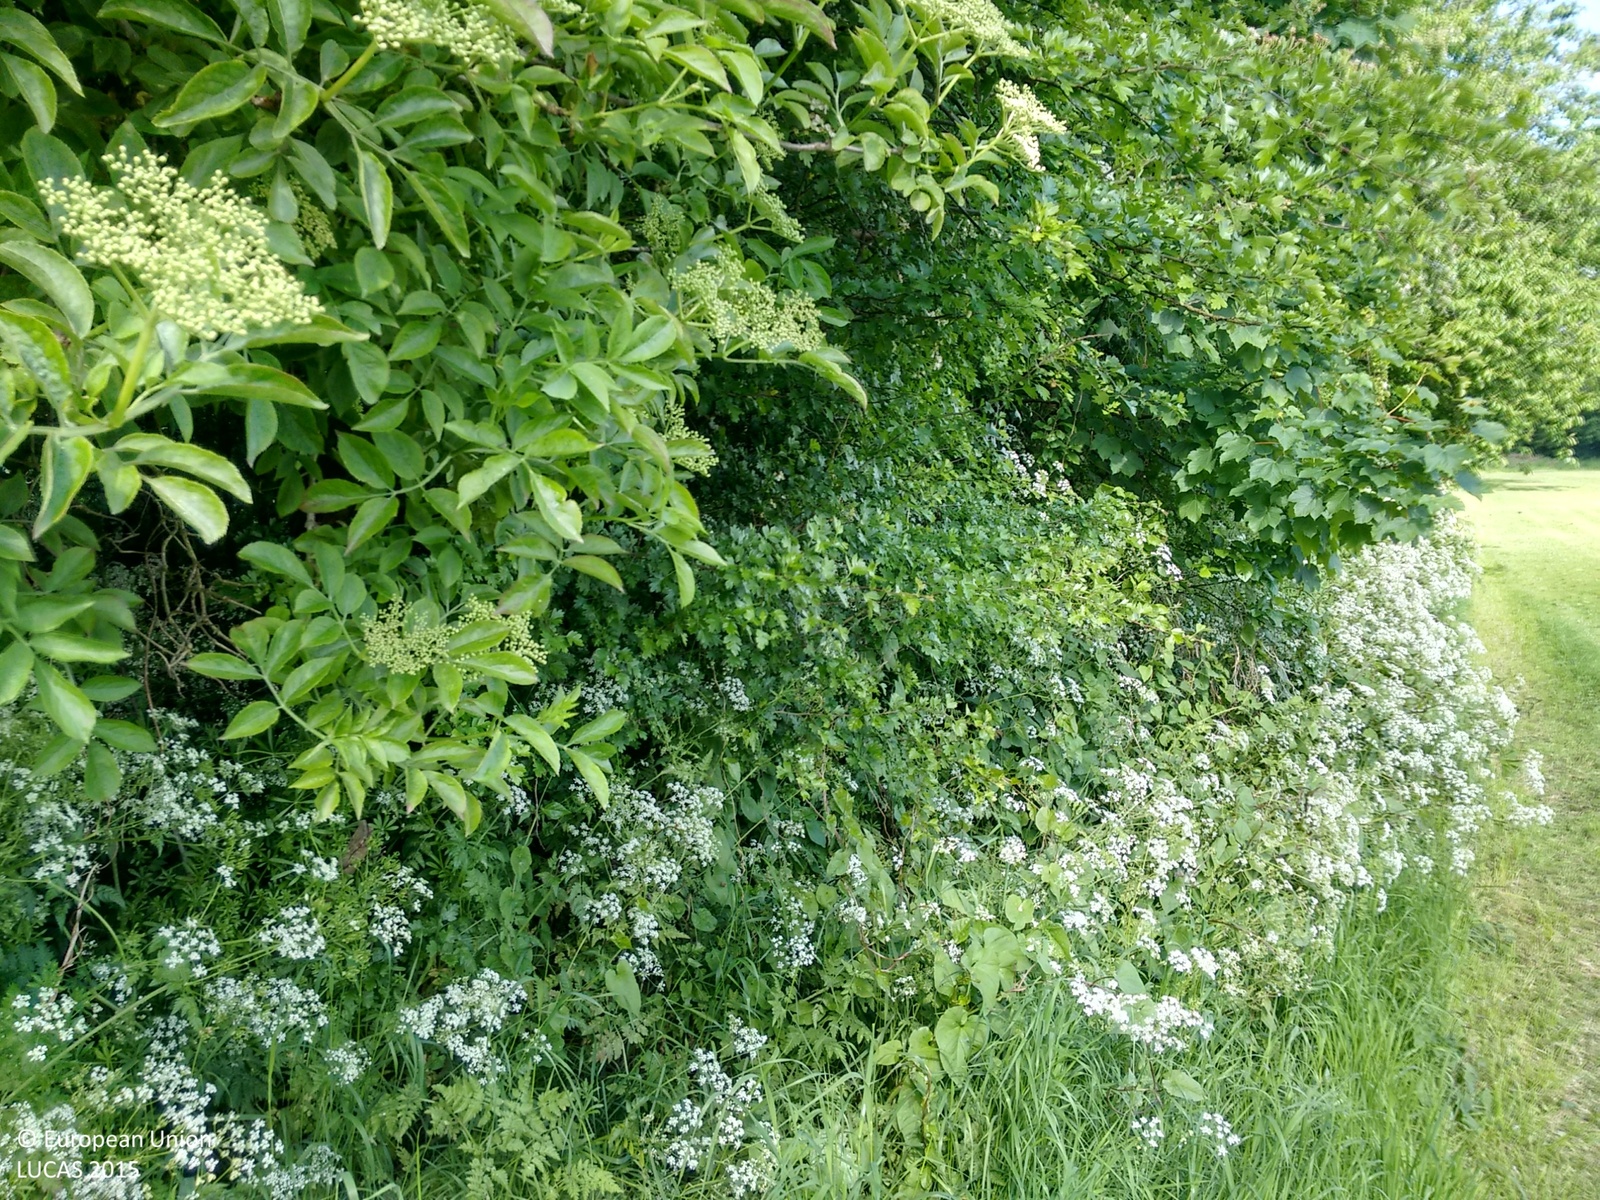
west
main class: Grassland
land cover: Grassland with sparse tree/shrub cover
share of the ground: > 75 %
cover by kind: herbaceous plants 85 %, shrubs 10 %, broadleaved forest trees 5 %
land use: Amenities, museums, leisure
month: June
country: GB
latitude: 53.5584
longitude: -0.1019
